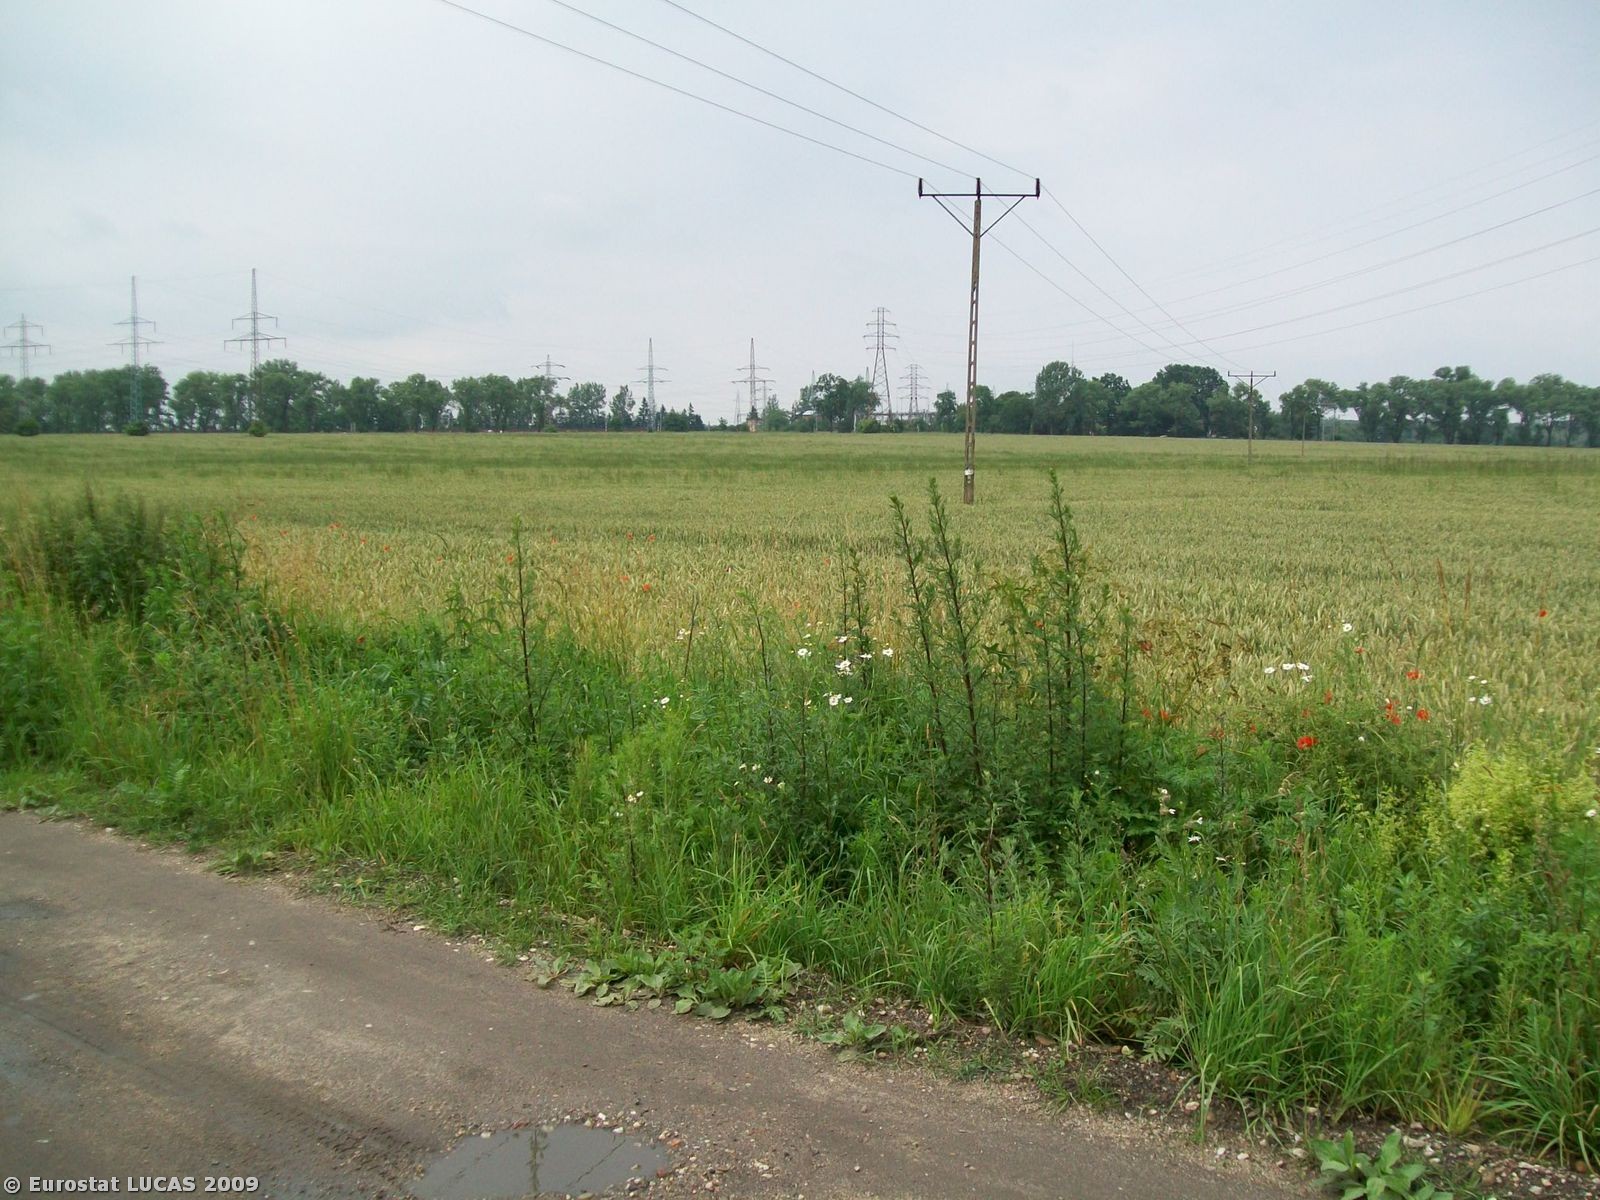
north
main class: Cropland
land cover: Common wheat
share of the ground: > 75 %
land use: Agriculture (excluding fallow land and kitchen gardens)
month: June
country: PL
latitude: 51.1757
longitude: 16.0854
